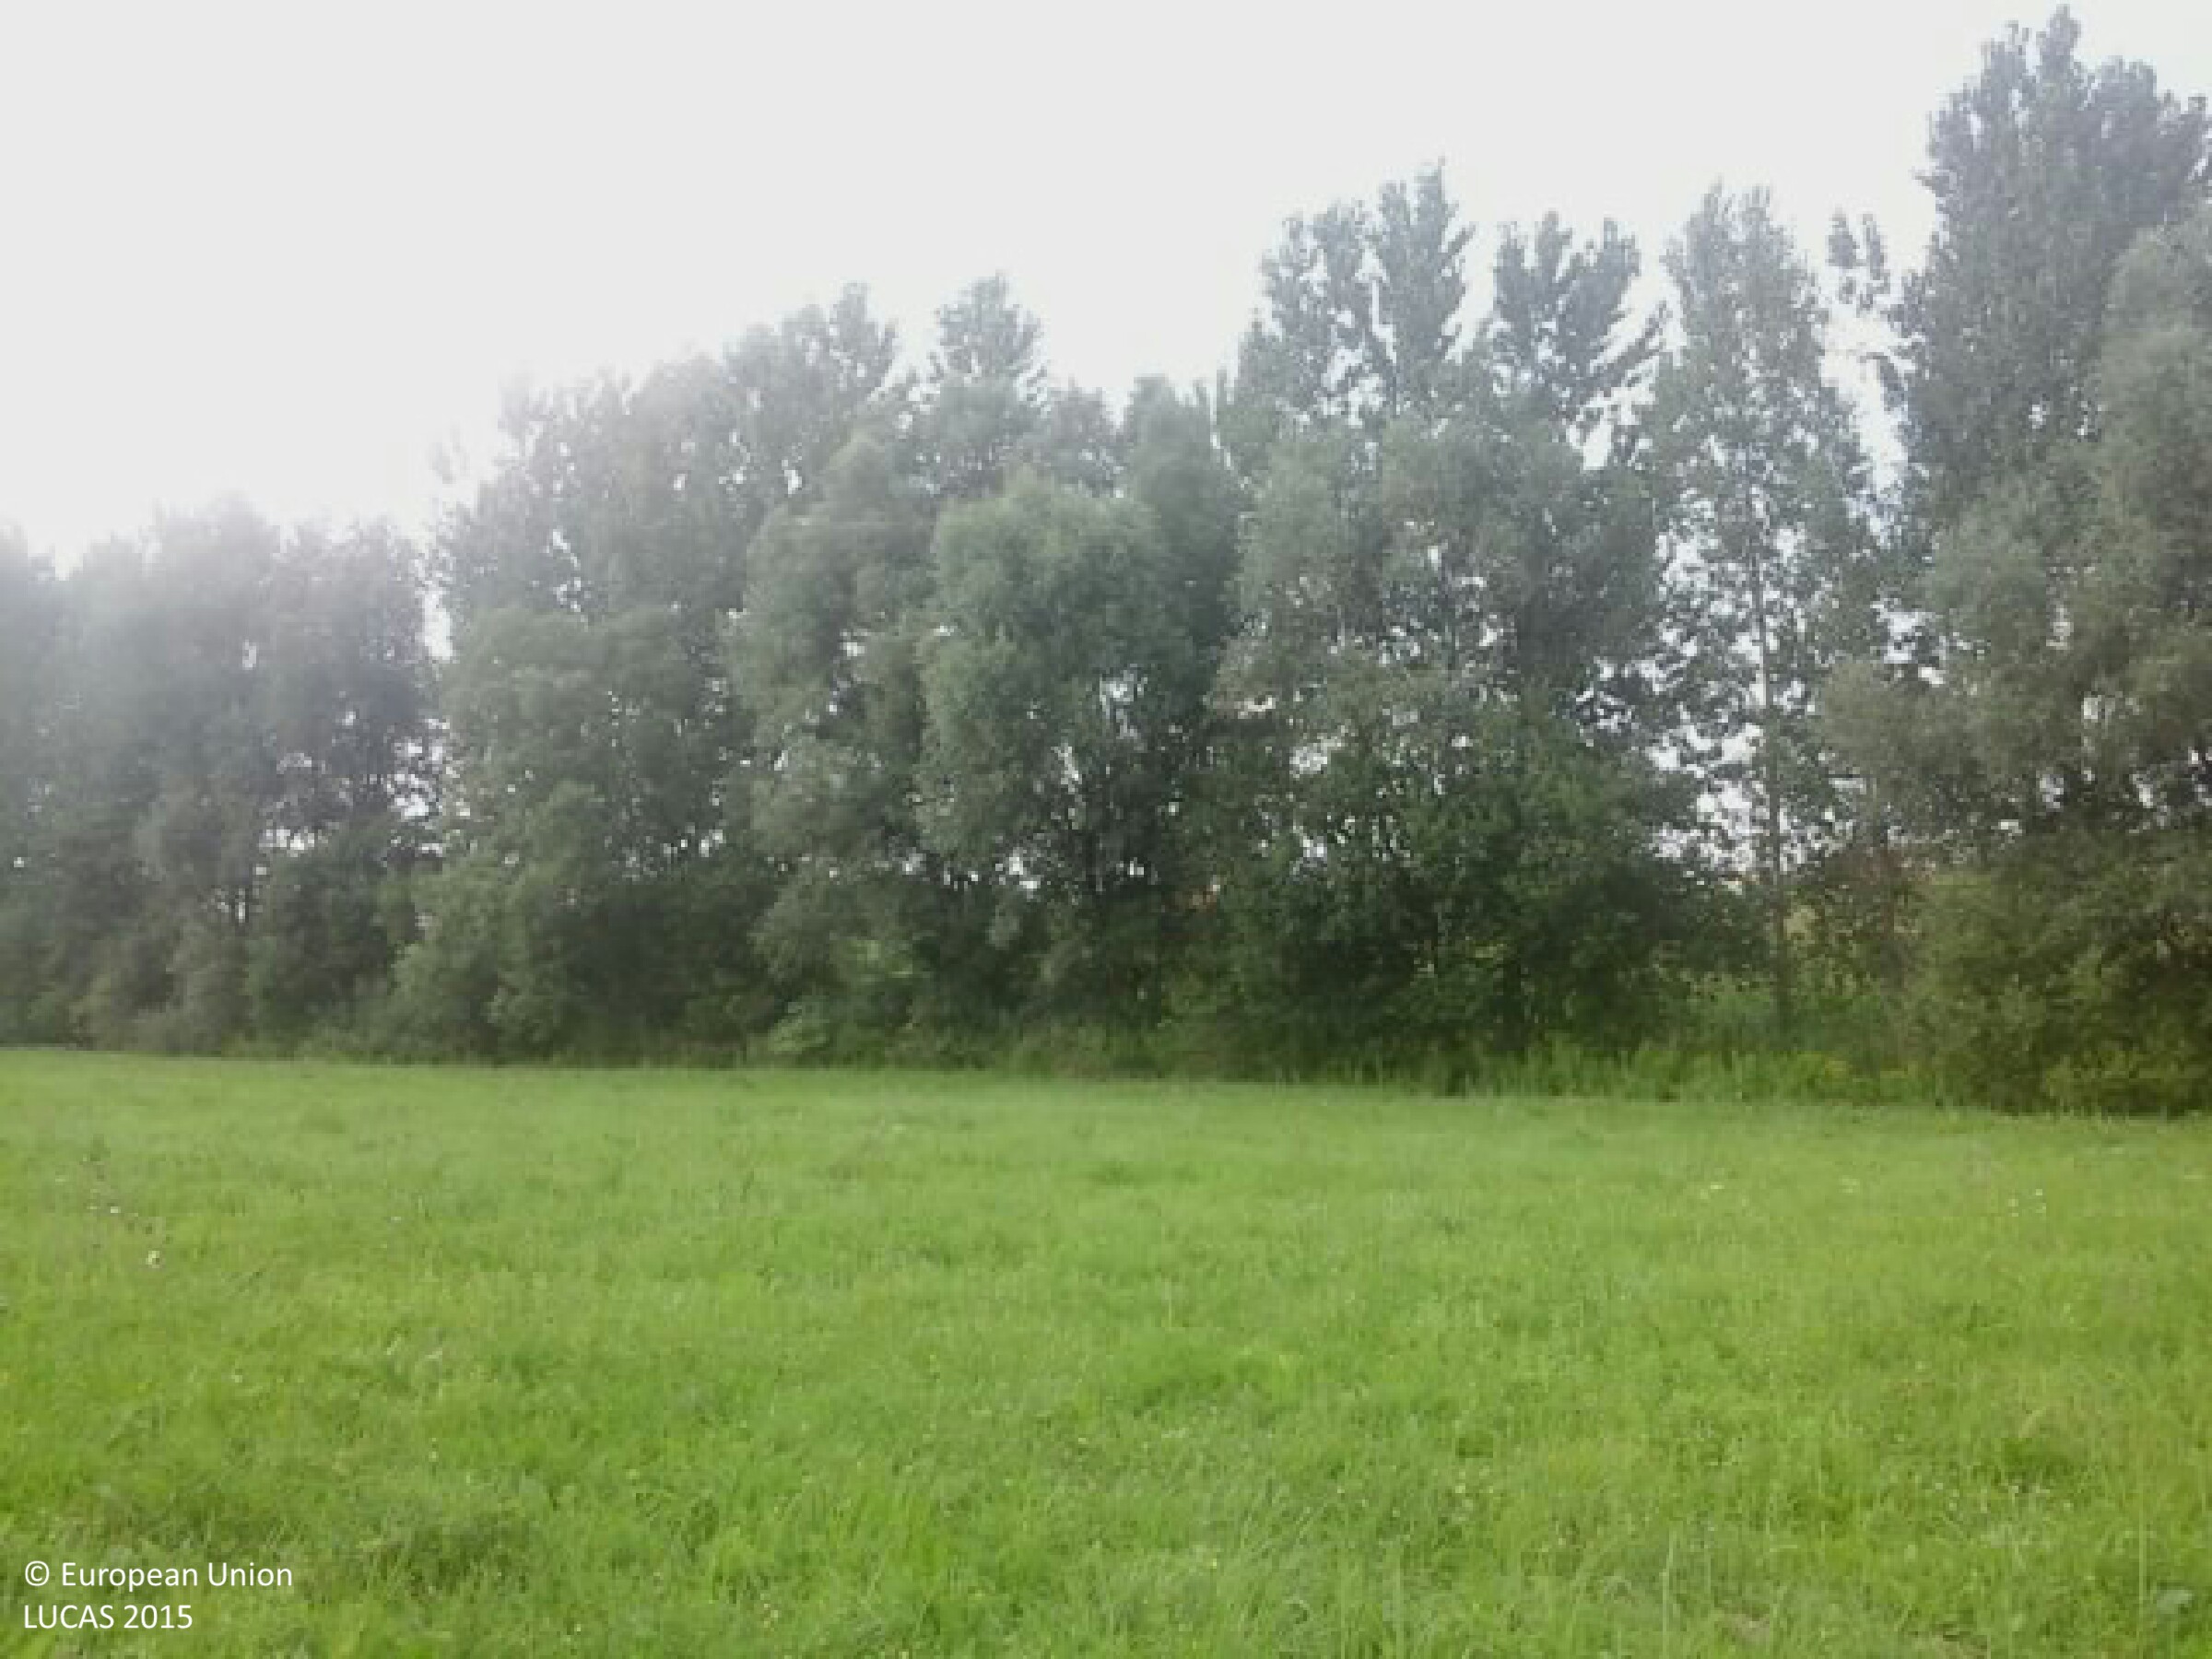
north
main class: Grassland
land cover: Grassland without tree/shrub cover
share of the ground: > 75 %
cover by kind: herbaceous plants 100 %
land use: Agriculture (excluding fallow land and kitchen gardens)
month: August
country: HU
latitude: 46.3092
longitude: 18.4103
